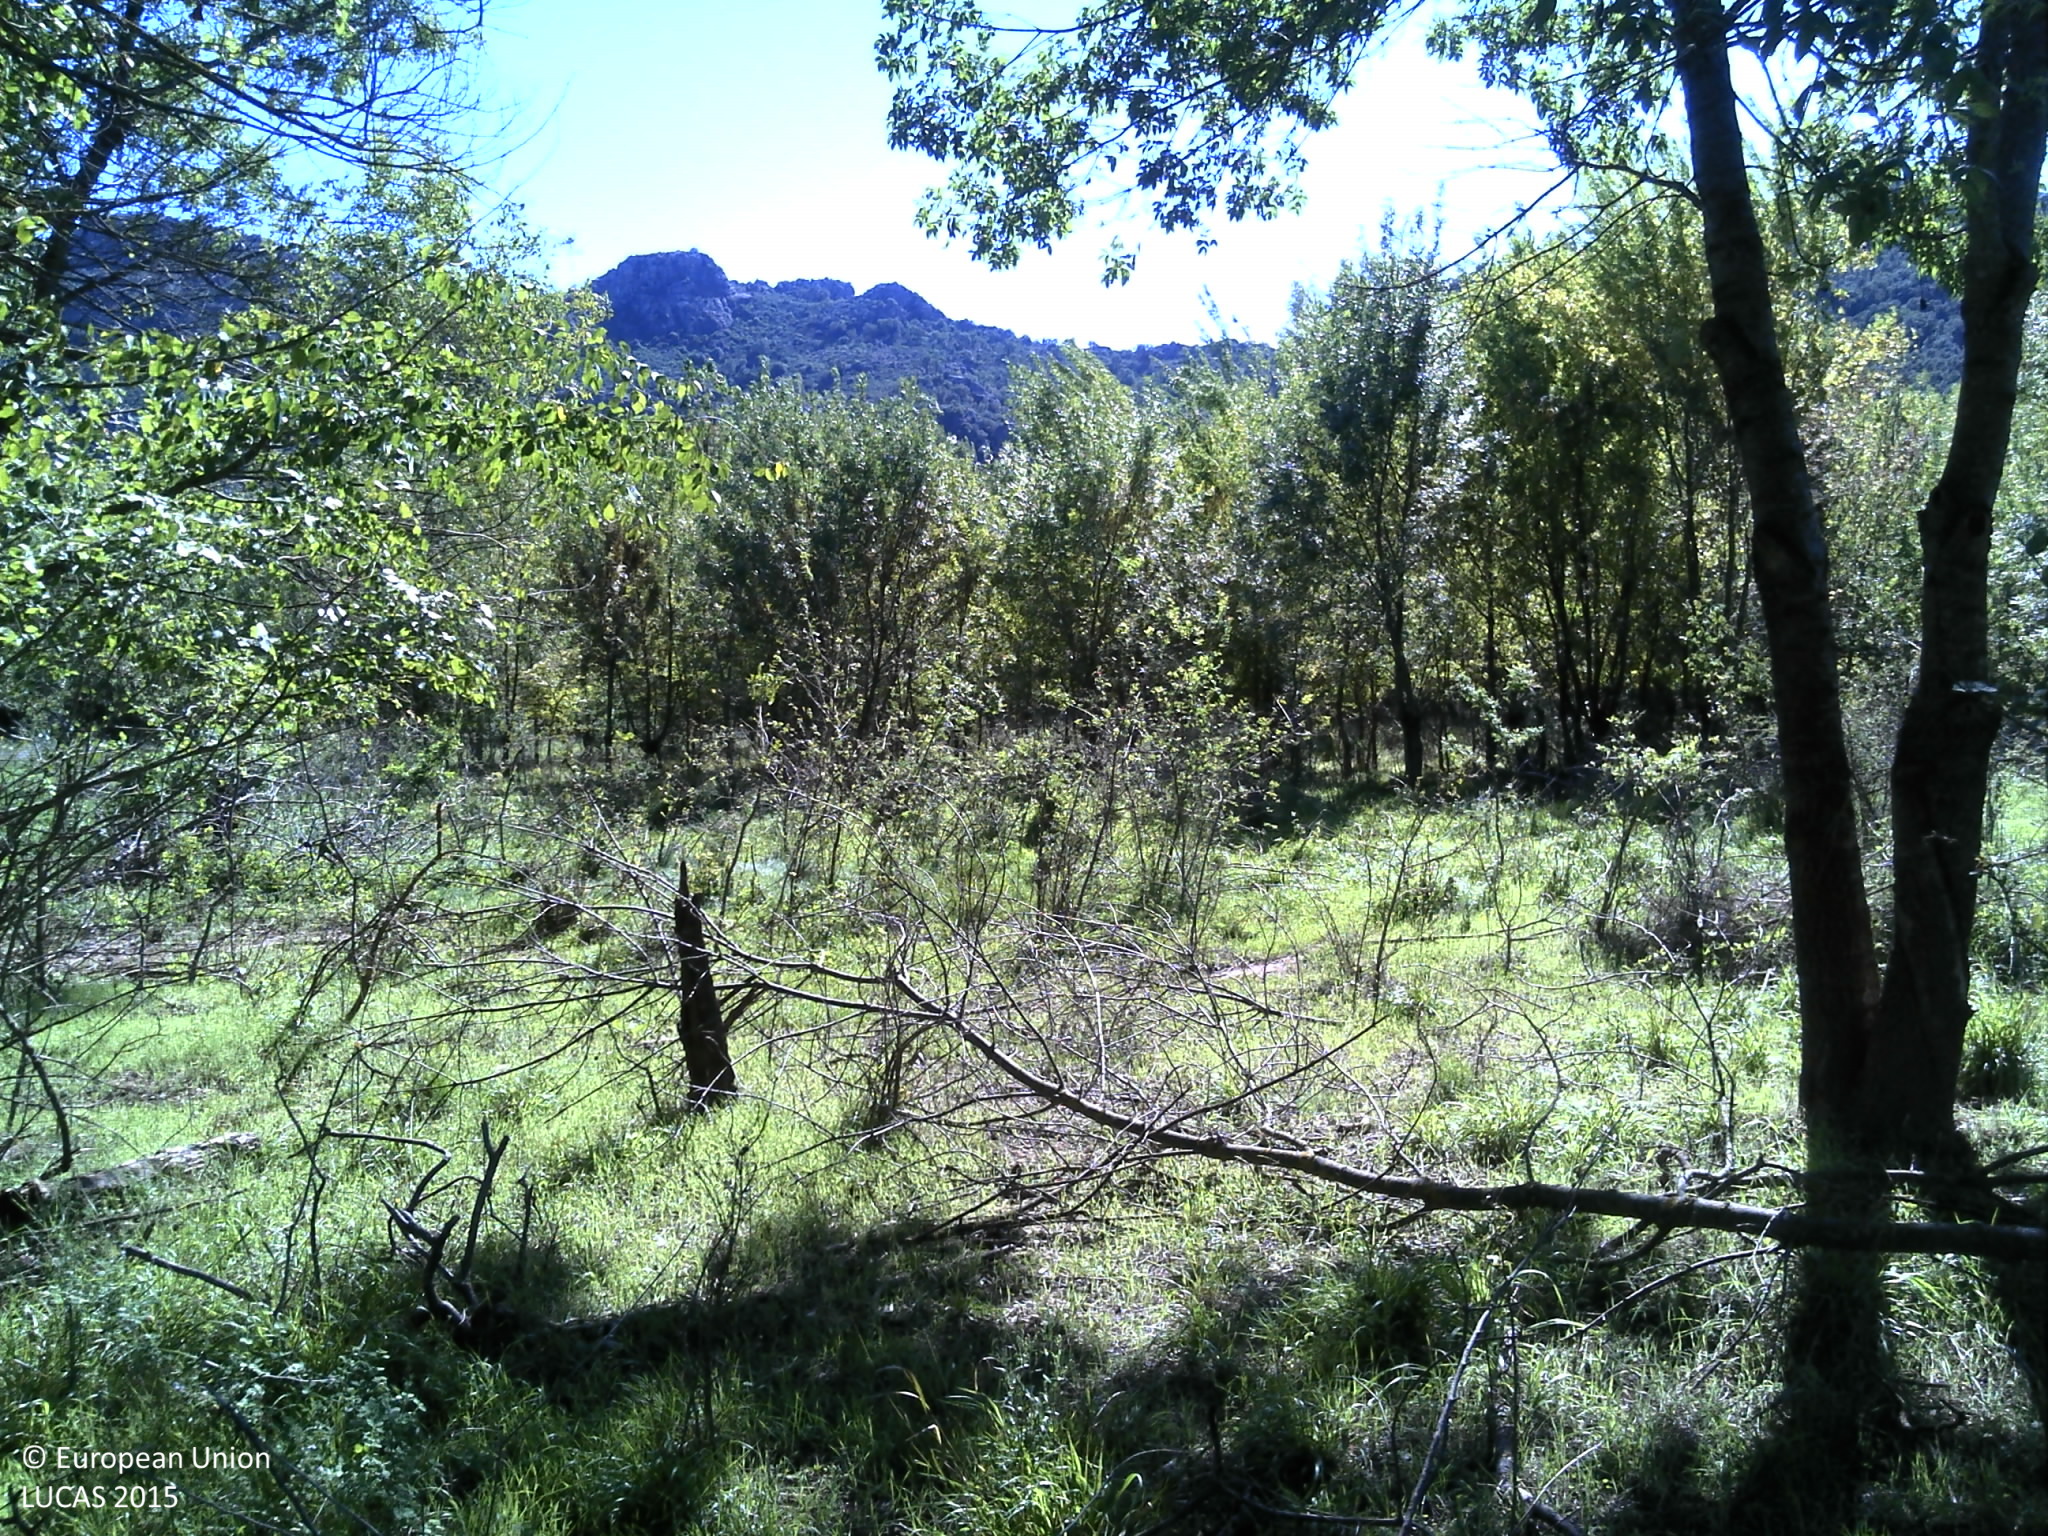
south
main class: Woodland
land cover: Broadleaved woodland
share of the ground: > 75 %
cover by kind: broadleaved forest trees 60 %, herbaceous plants 30 %, shrubs 10 %
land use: Forestry
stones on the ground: < 10 %
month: October
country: FR
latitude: 43.4638
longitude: 6.5847
